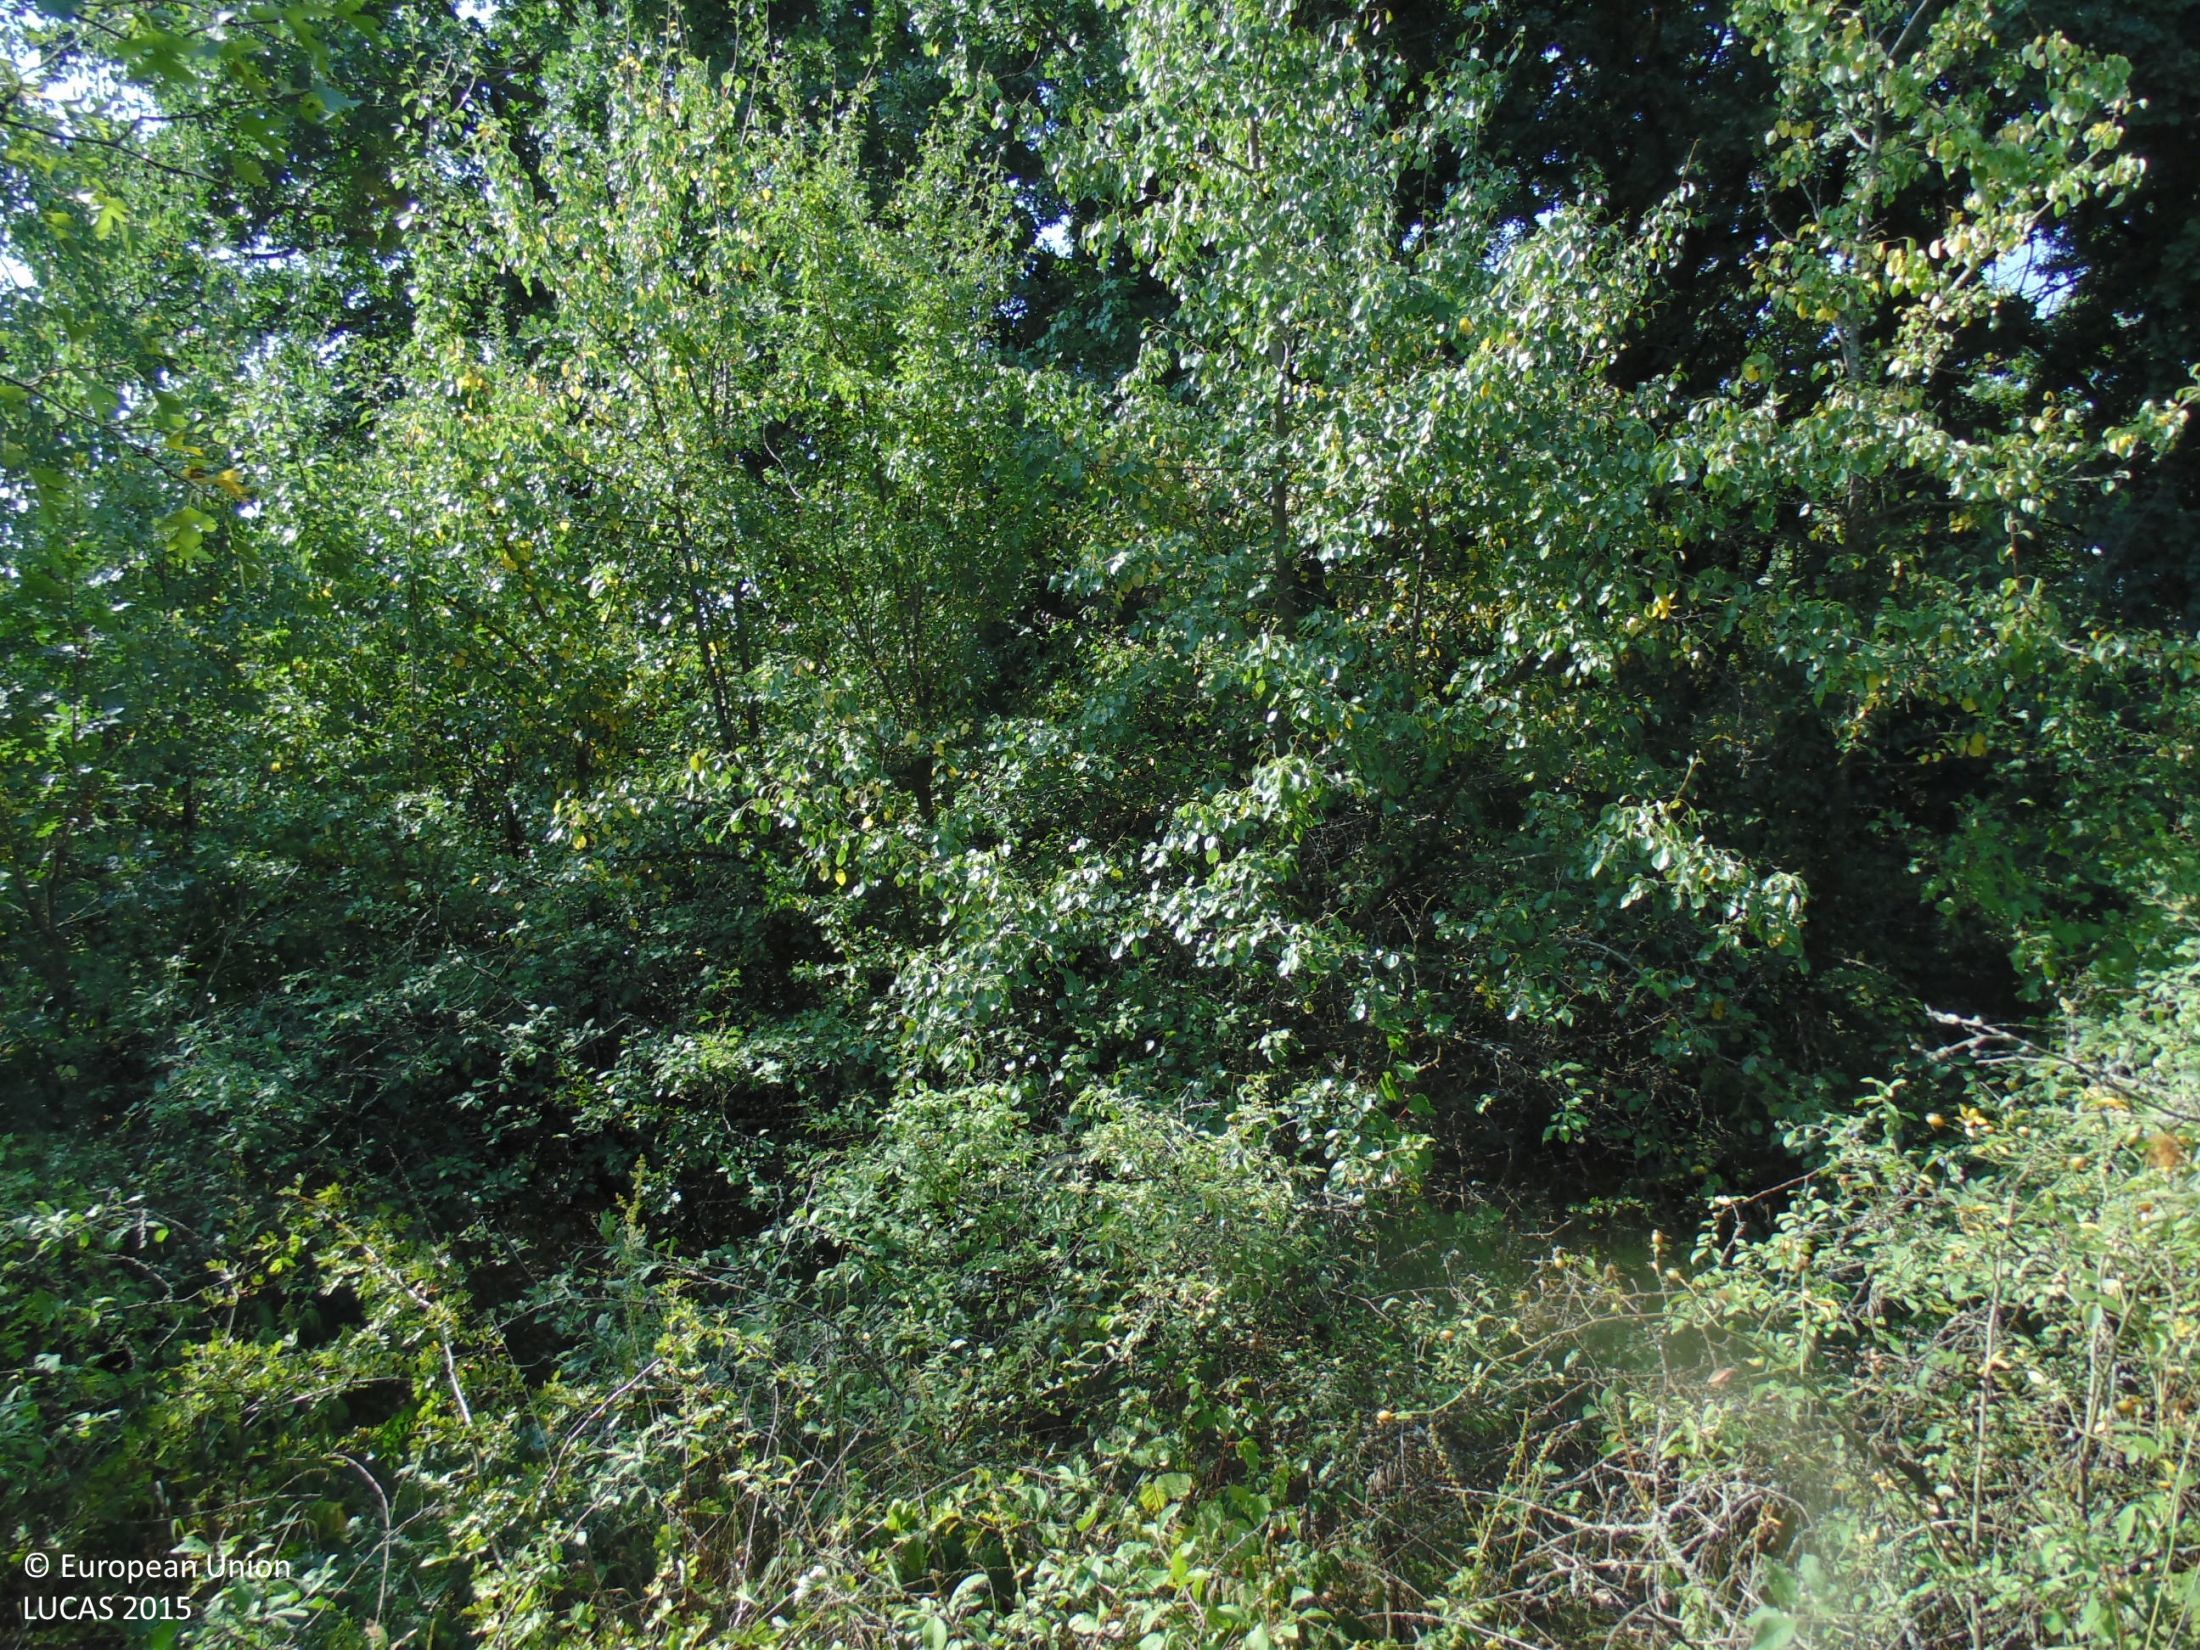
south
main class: Shrubland
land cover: Shrubland with sparse tree cover
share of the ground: > 75 %
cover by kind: shrubs 80 %, herbaceous plants 15 %, broadleaved forest trees 5 %
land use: Semi-natural and natural areas not in use
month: August
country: BG
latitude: 43.9132
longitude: 27.7387
